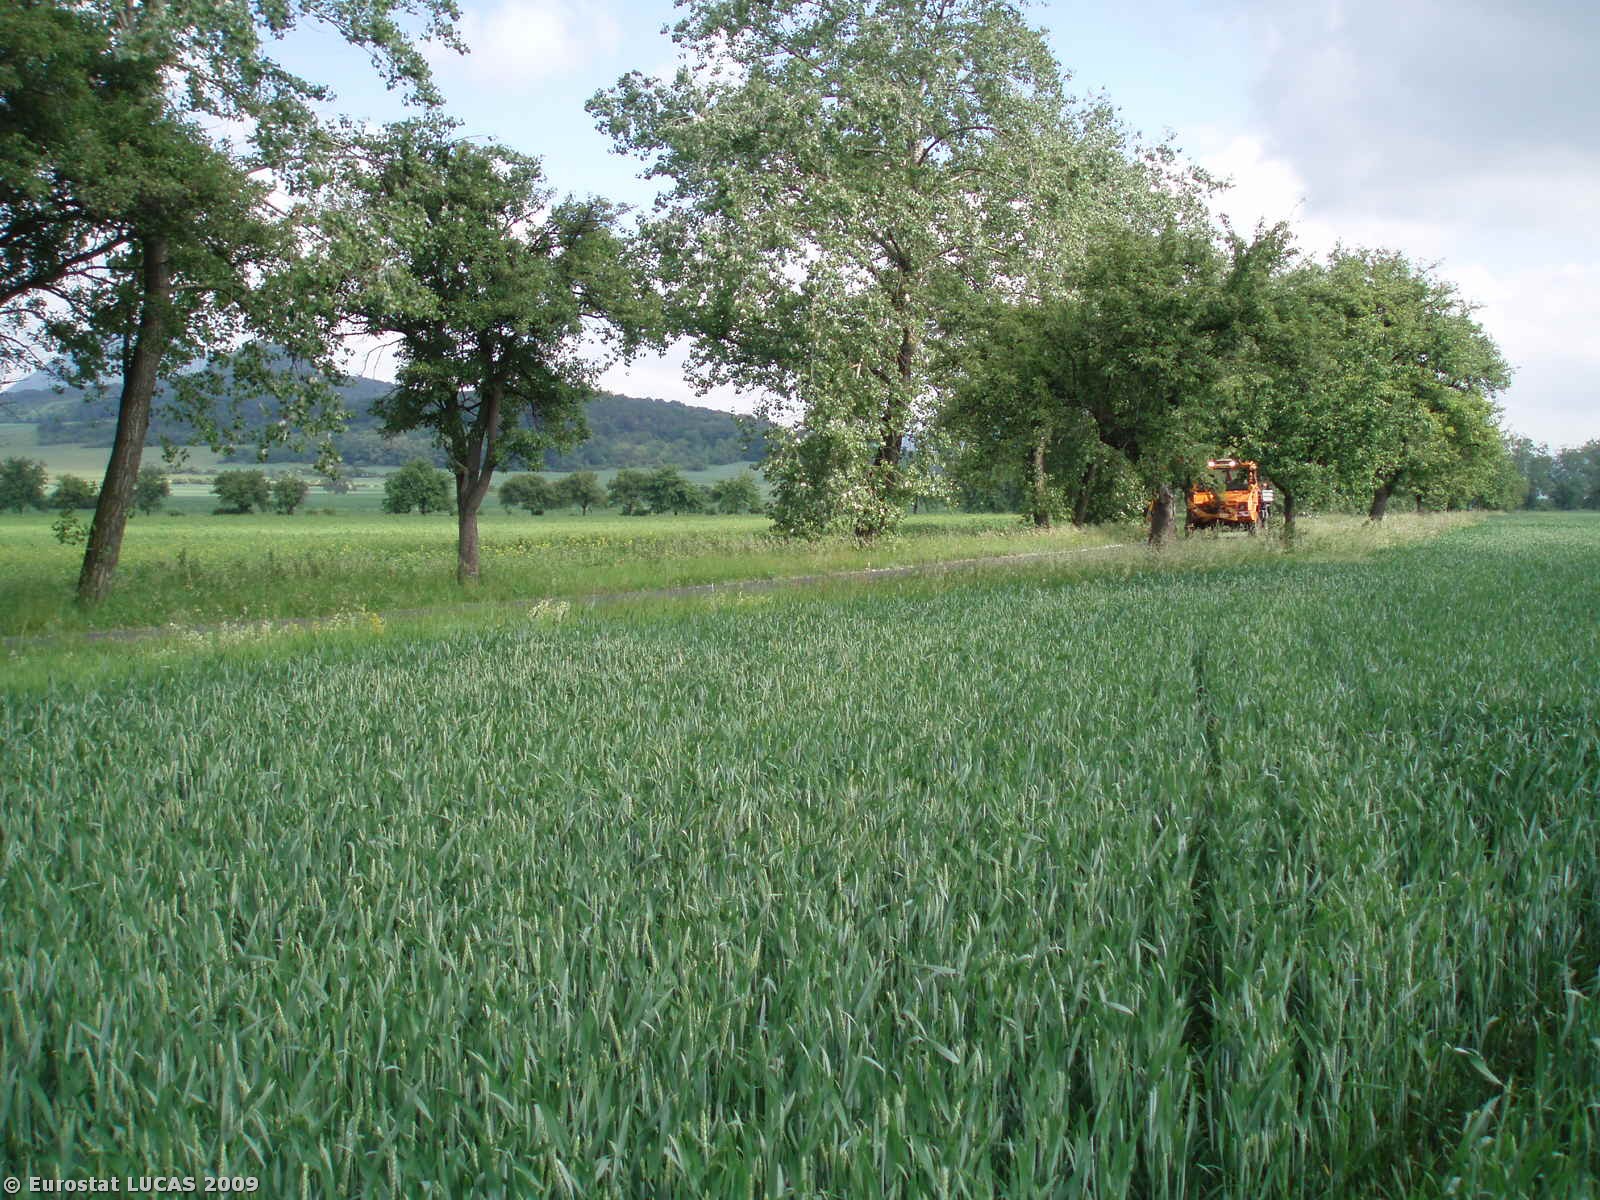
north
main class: Cropland
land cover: Common wheat
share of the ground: > 75 %
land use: Agriculture (excluding fallow land and kitchen gardens)
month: June
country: CZ
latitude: 50.5115
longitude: 13.9635
